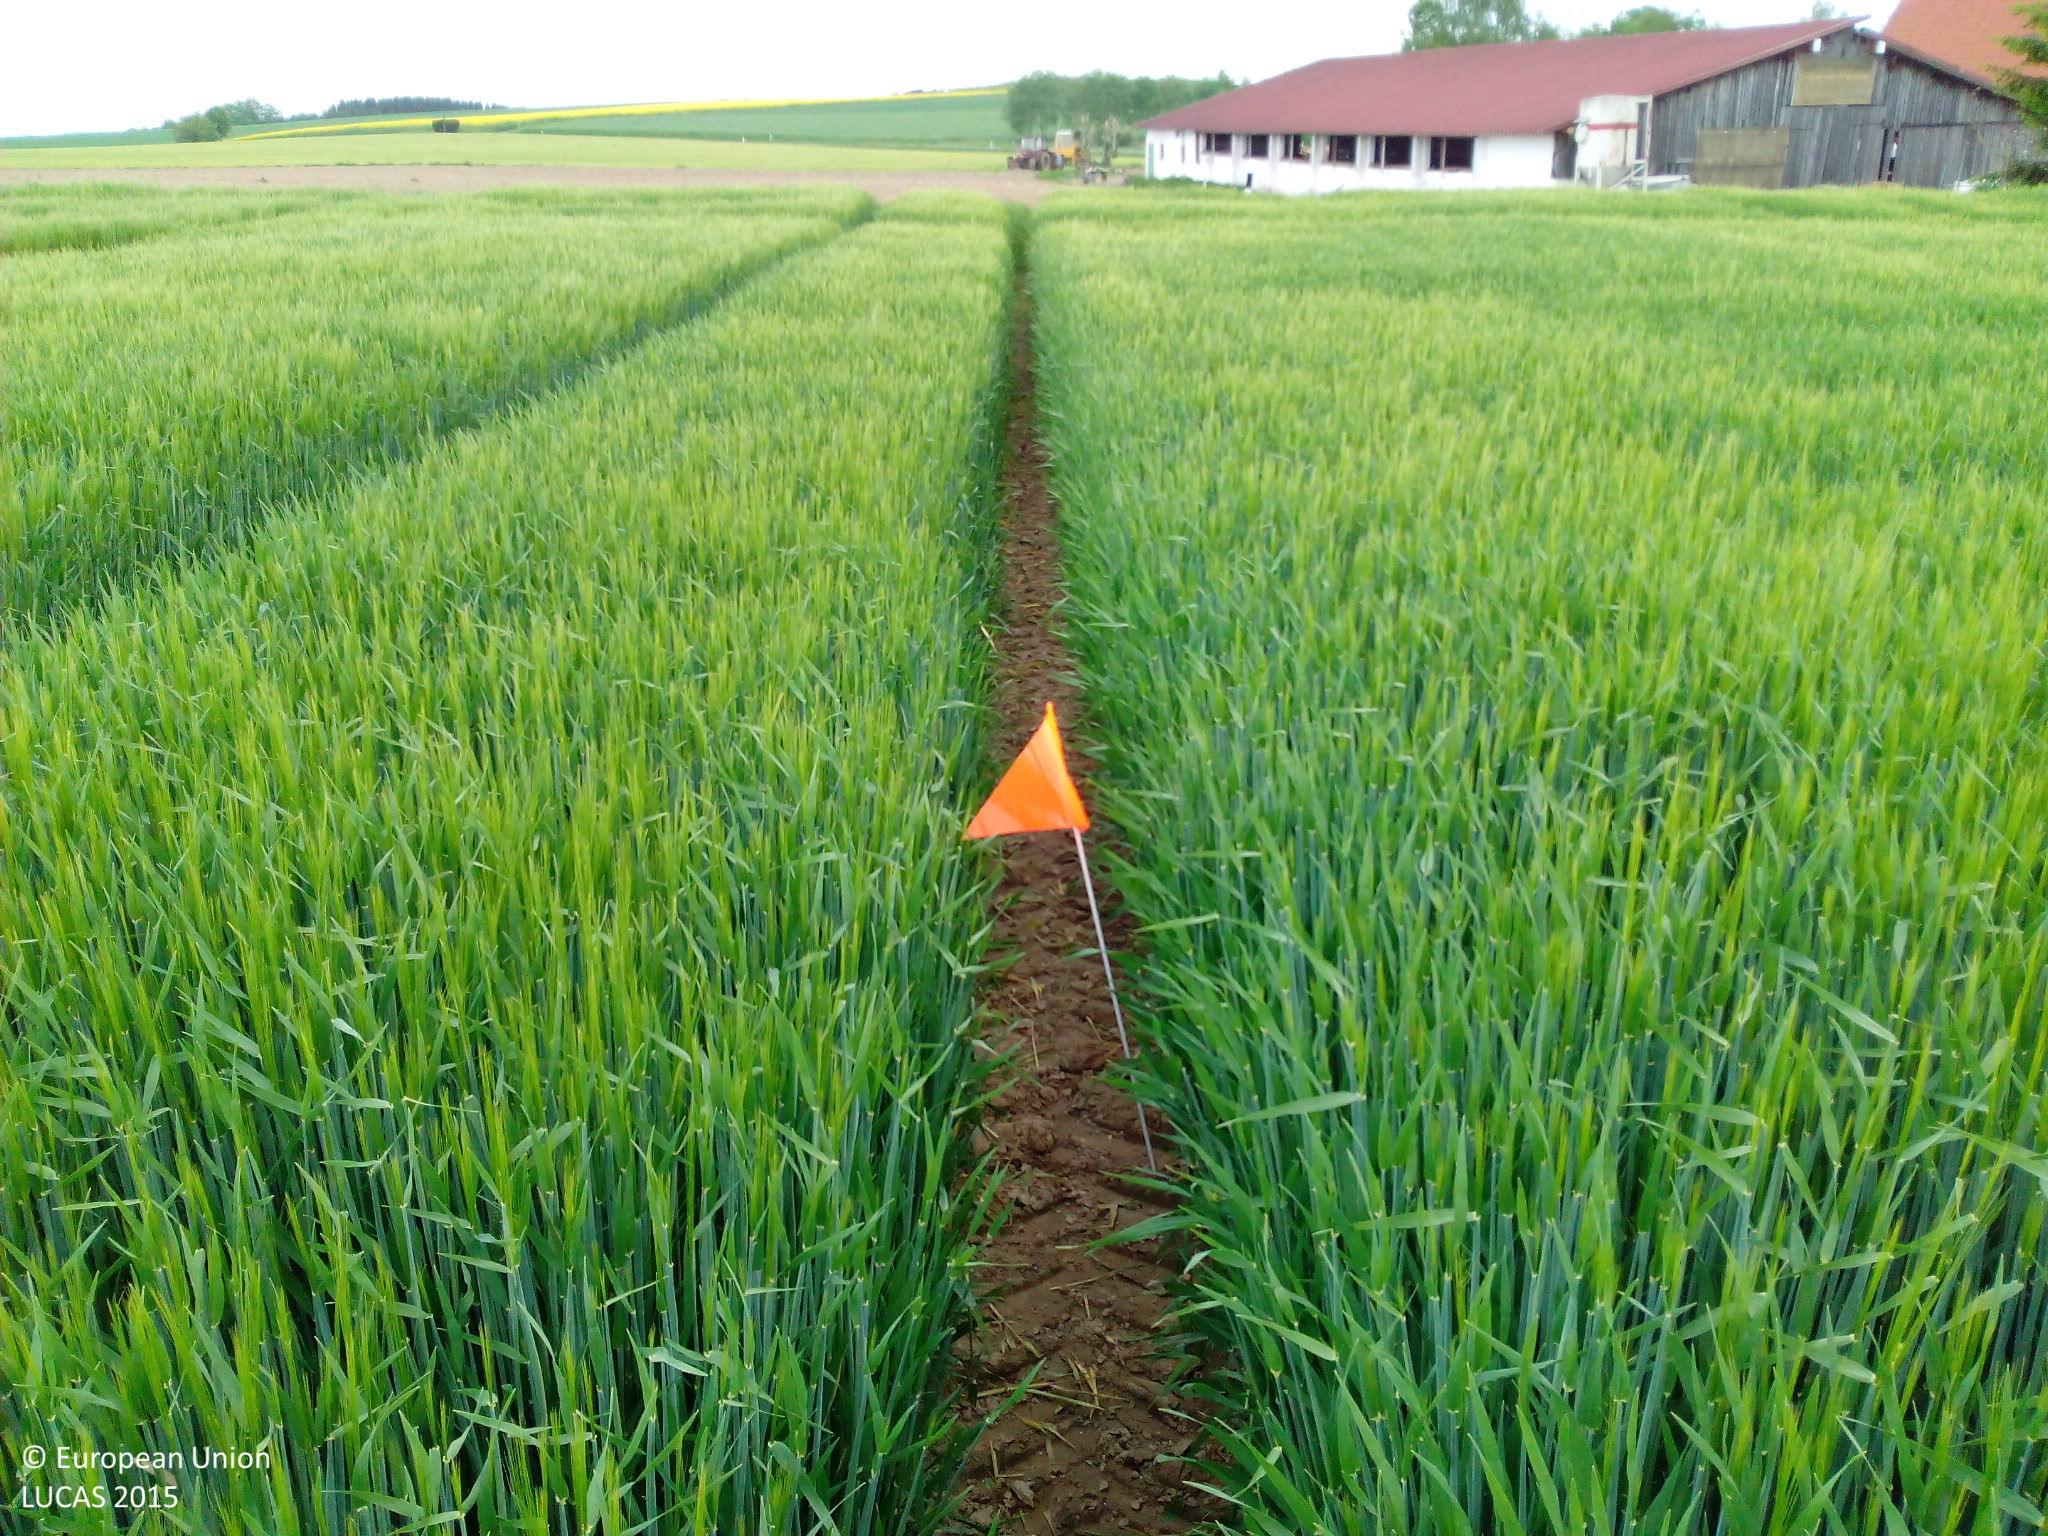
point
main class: Cropland
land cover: Barley
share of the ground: > 75 %
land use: Agriculture (excluding fallow land and kitchen gardens)
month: May
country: DE
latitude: 47.9875
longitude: 9.3171
